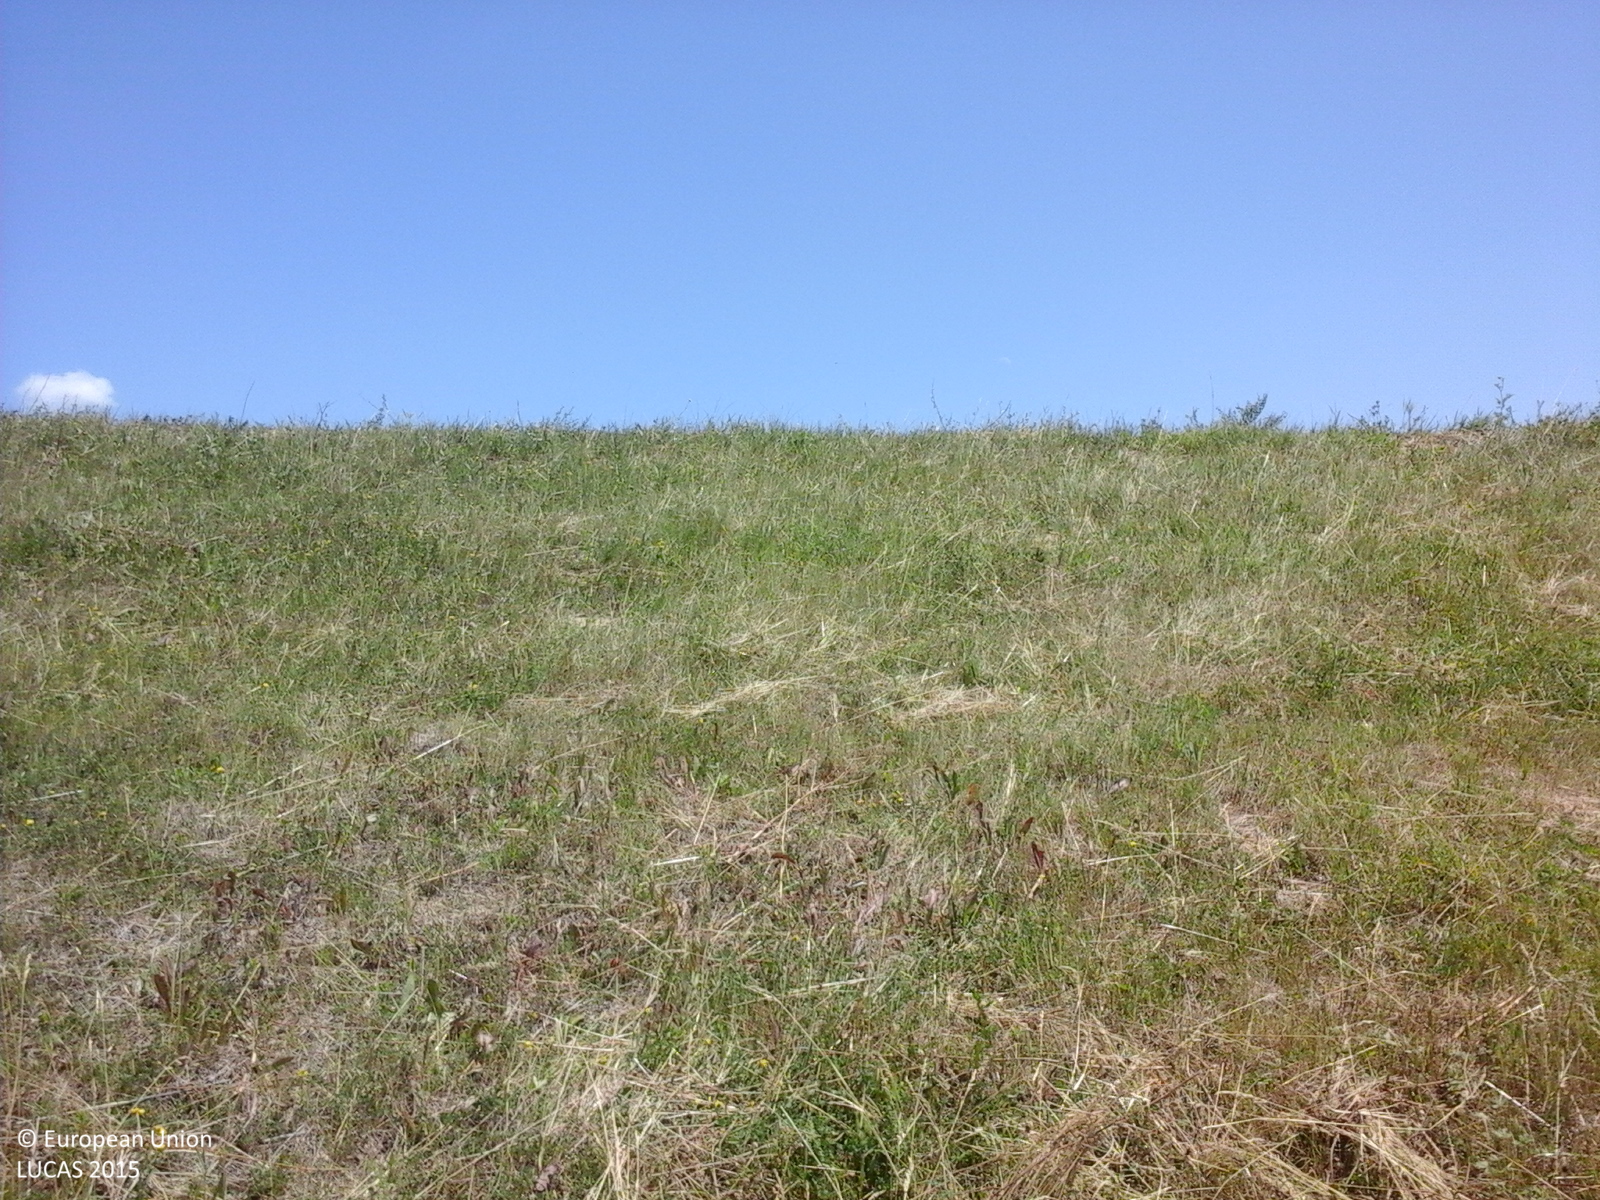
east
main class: Grassland
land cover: Grassland without tree/shrub cover
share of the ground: > 75 %
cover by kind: herbaceous plants 100 %
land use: Agriculture (excluding fallow land and kitchen gardens)
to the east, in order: Grassland without tree/shrub cover; Artificial constructions; Grassland without tree/shrub cover; Maize; Fences; Other root crops; Fences; Potatoes; Fences; Potatoes; Maize; Artificial constructions in urban areas; Lucerne; Fences; Sugar beet; Dry pulses; Other root crops
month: June
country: RO
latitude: 47.0262
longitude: 26.9533
